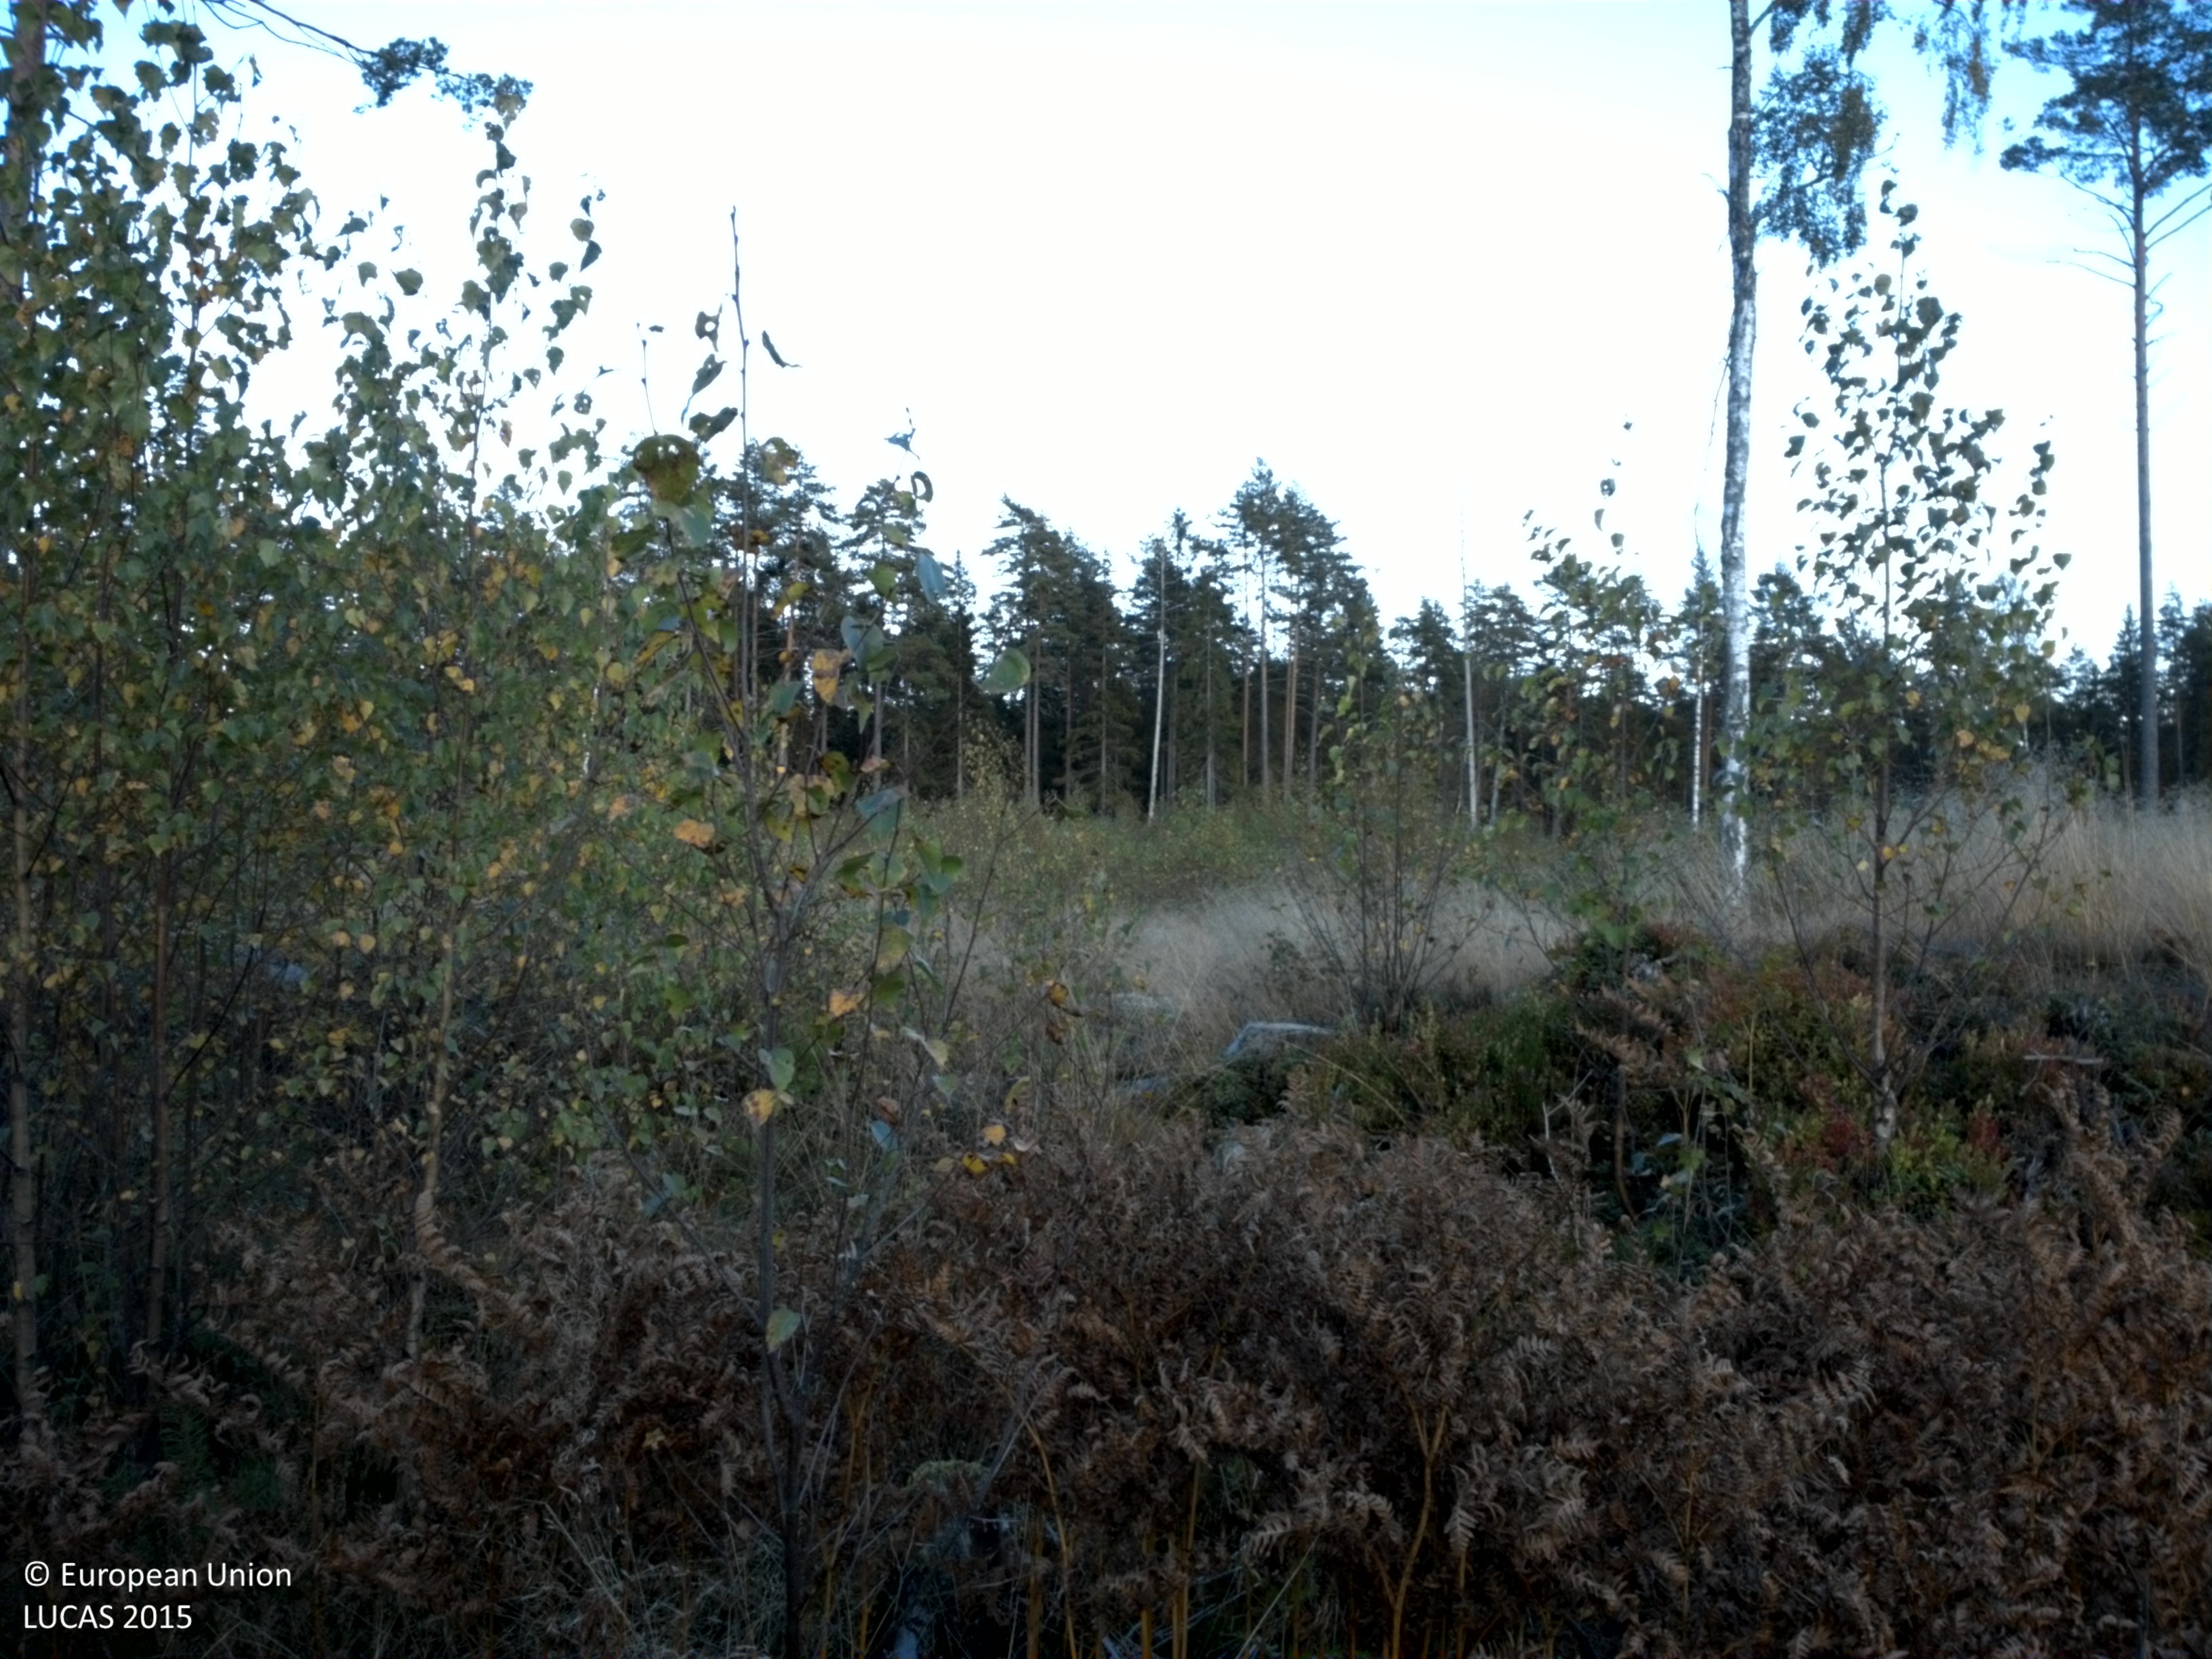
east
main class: Woodland
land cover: Broadleaved woodland
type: boreal forest
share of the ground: 25 - 50 %
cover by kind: broadleaved forest trees 45 %, herbaceous plants 40 %, unconsolidated bare surface 10 %, coniferous forest trees 5 %
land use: Forestry
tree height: < 5 m
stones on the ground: < 10 %
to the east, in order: Broadleaved woodland; Other coniferous woodland; Pine dominated coniferous woodland; Other coniferous woodland
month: September
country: SE
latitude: 59.9736
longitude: 16.5659
